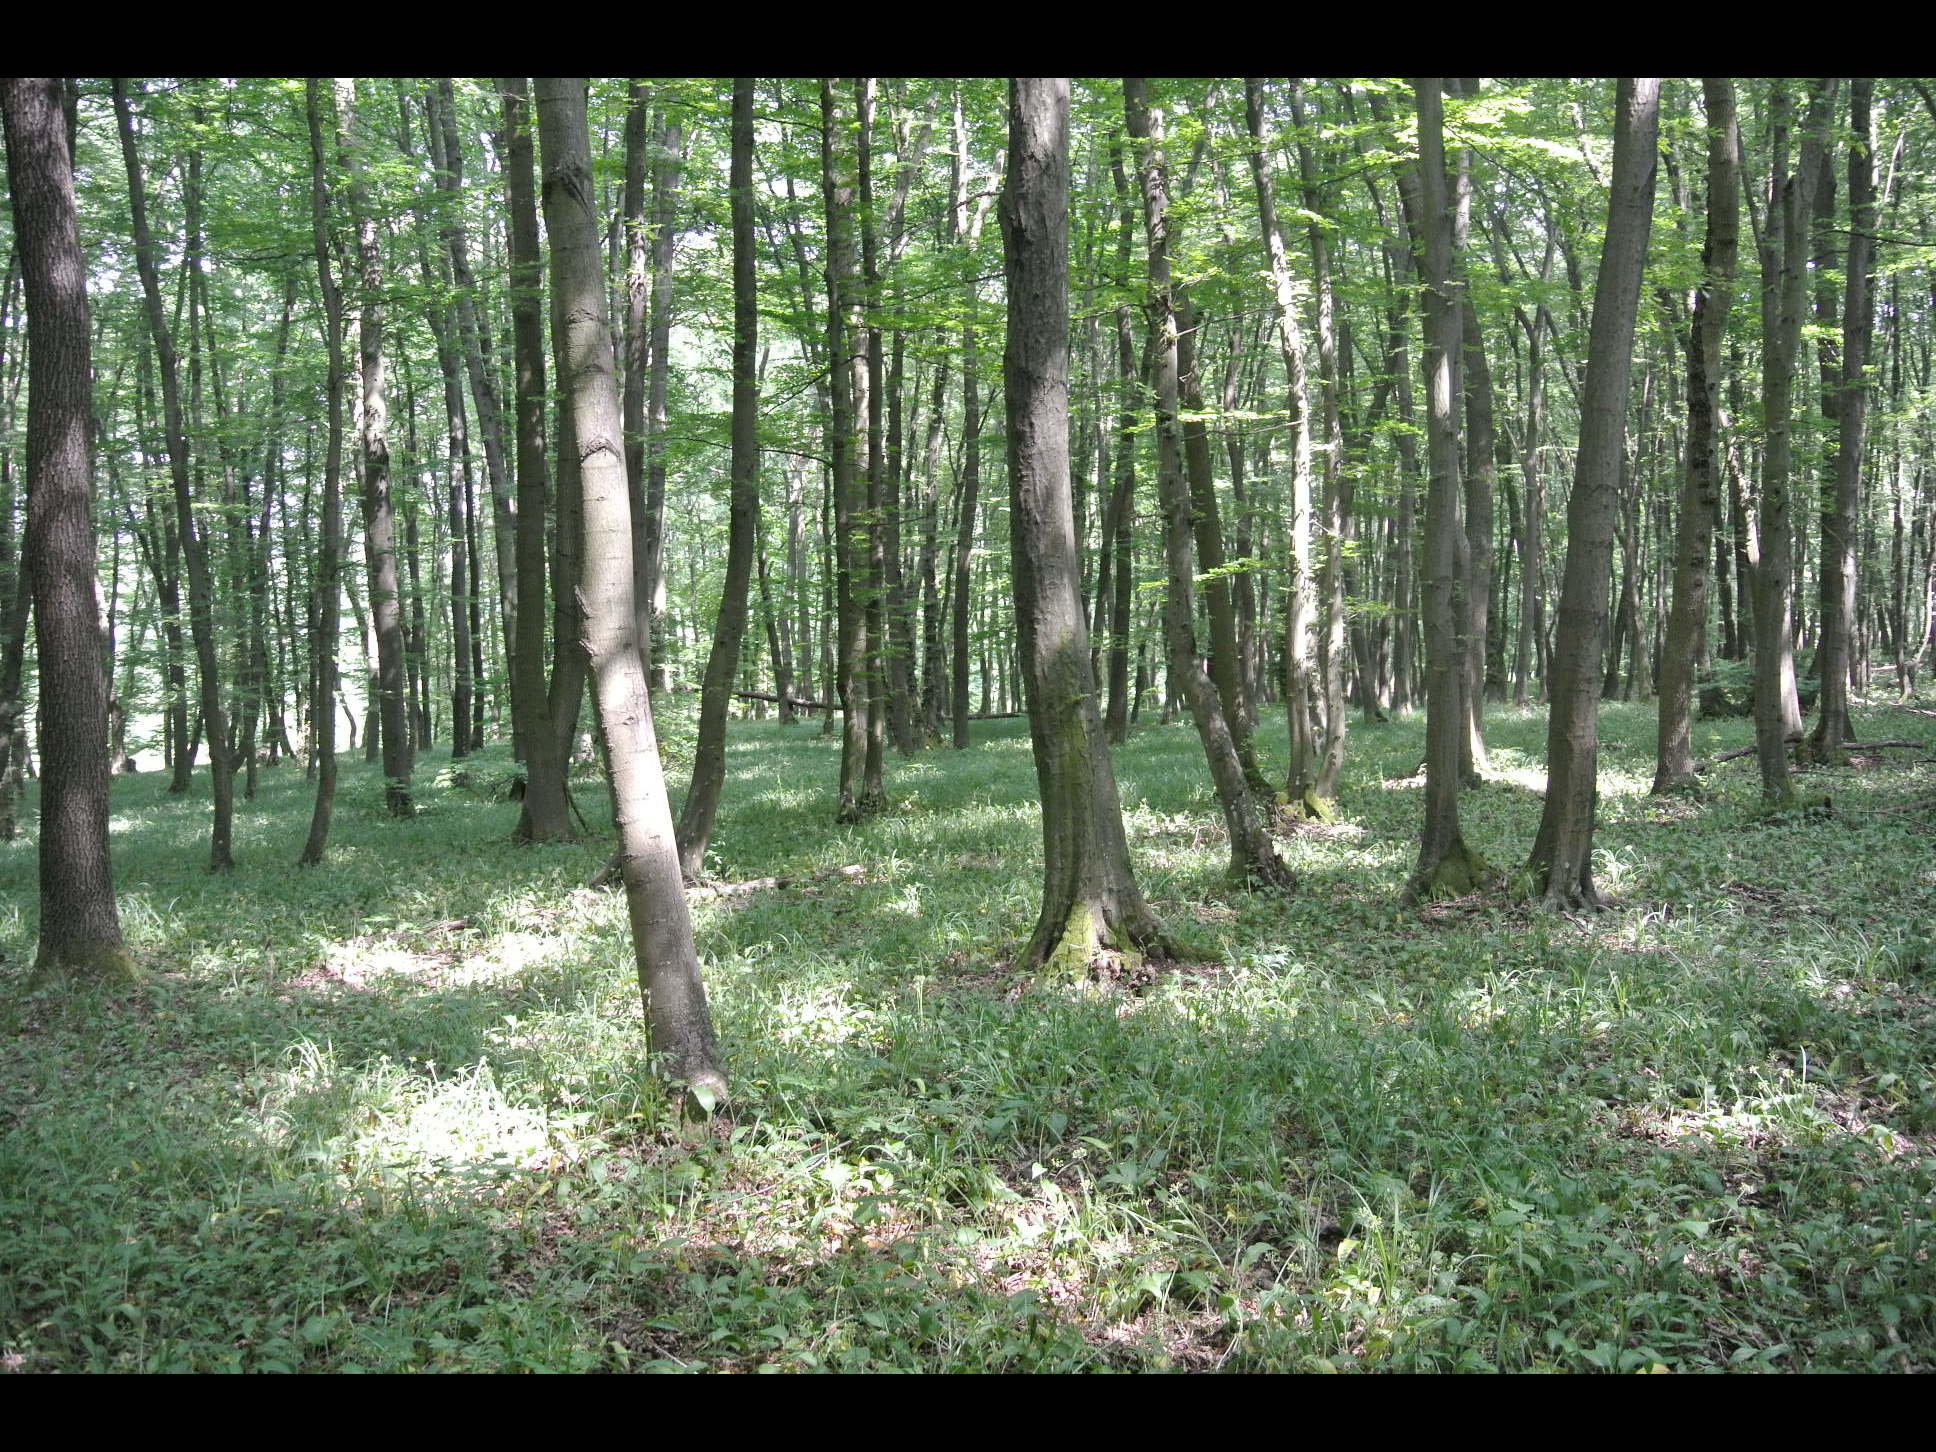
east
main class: Woodland
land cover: Broadleaved woodland
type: mesophytic deciduous forest
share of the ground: > 75 %
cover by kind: broadleaved forest trees 100 %
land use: Forestry
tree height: > 5 m
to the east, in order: Broadleaved woodland; Tracks; Broadleaved woodland; Tracks; Broadleaved woodland; Shrubland with sparse tree cover
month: May
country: AT
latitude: 47.9808
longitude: 16.7449
